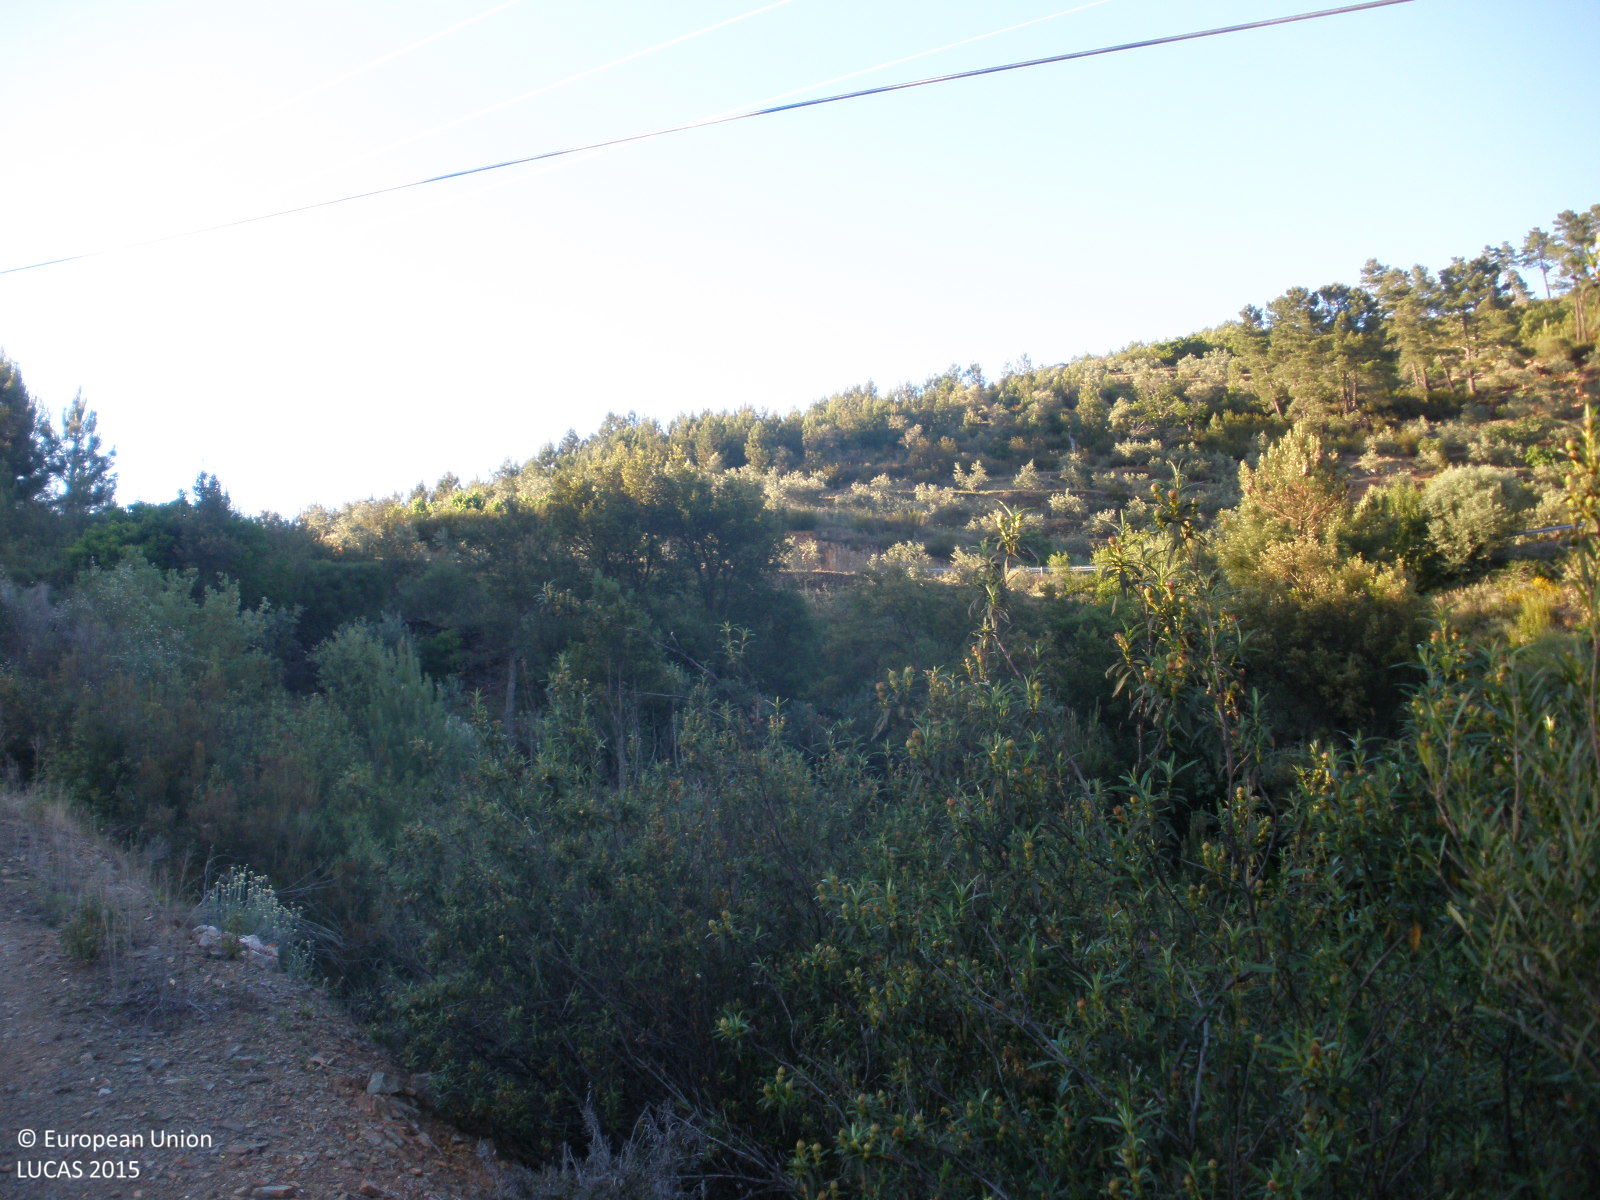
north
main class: Shrubland
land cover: Shrubland with sparse tree cover
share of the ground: > 75 %
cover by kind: shrubs 95 %, coniferous forest trees 5 %
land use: Semi-natural and natural areas not in use
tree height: < 5 m
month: May
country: ES
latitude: 40.3142
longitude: -6.2836
